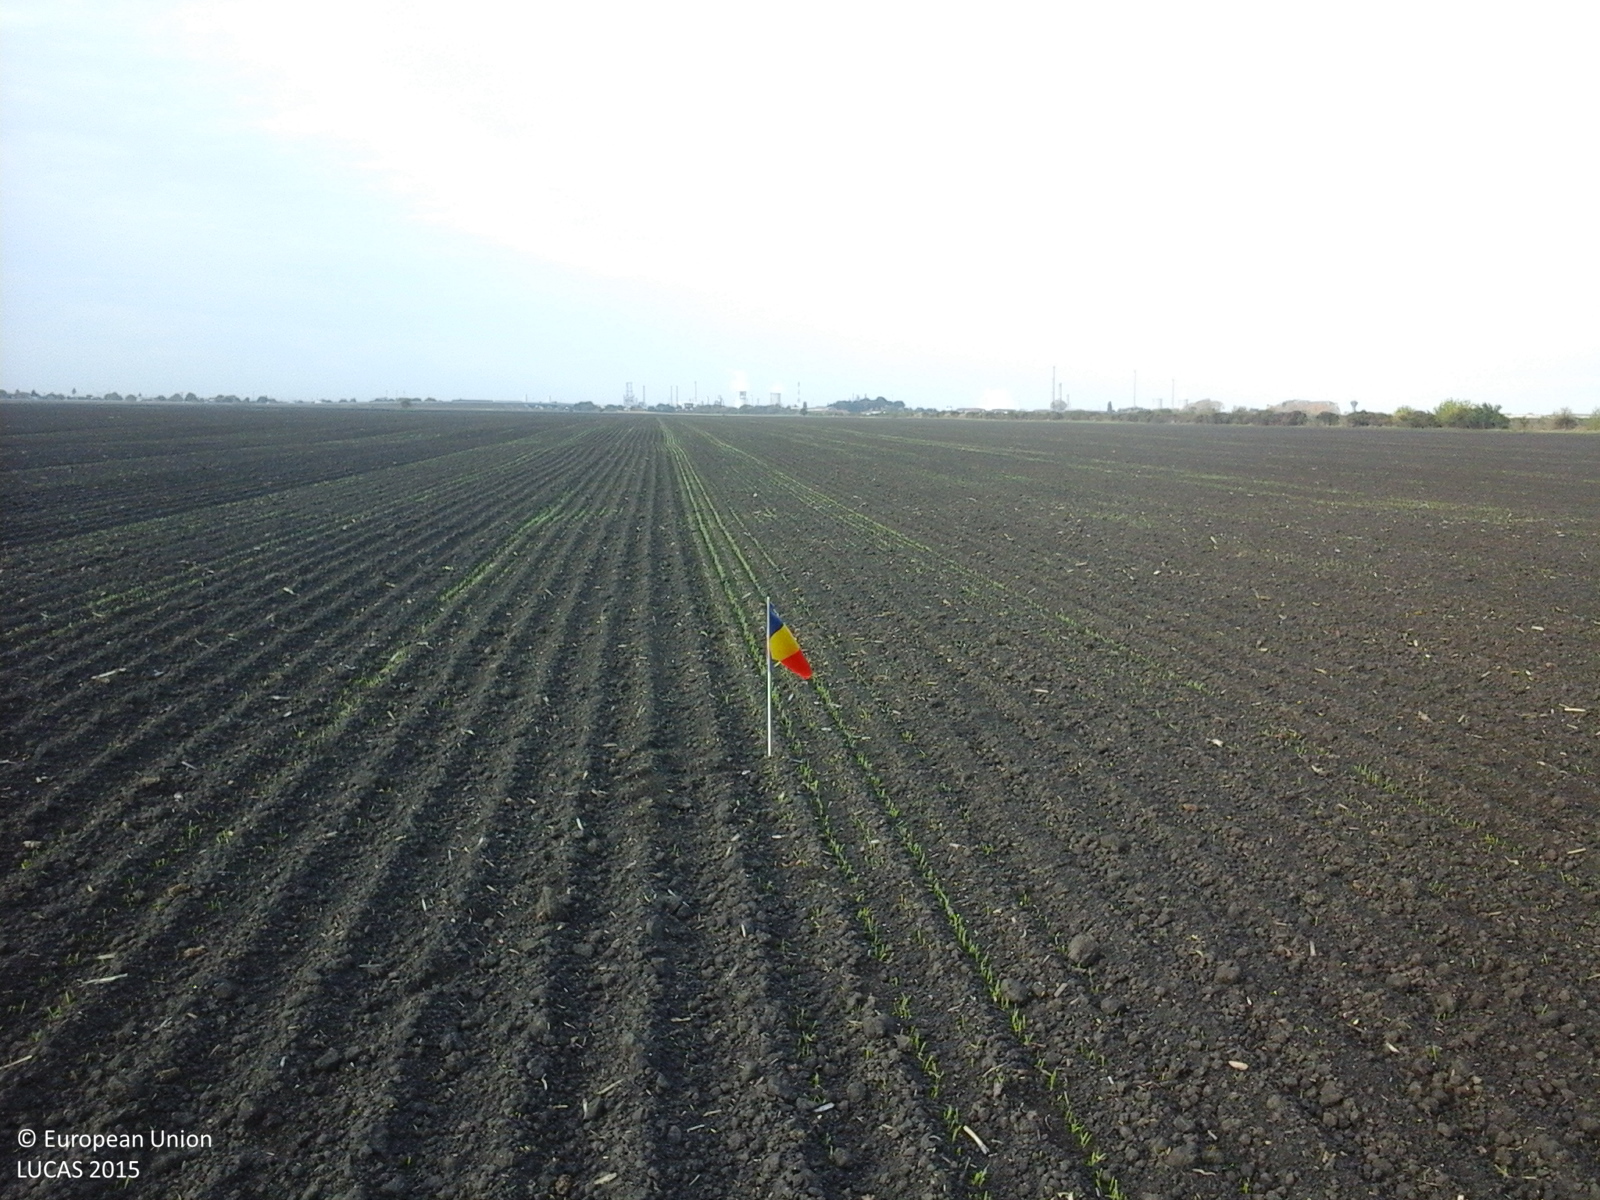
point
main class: Cropland
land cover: Maize
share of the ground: < 10 %
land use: Agriculture (excluding fallow land and kitchen gardens)
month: October
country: RO
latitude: 44.8867
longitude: 26.0744
